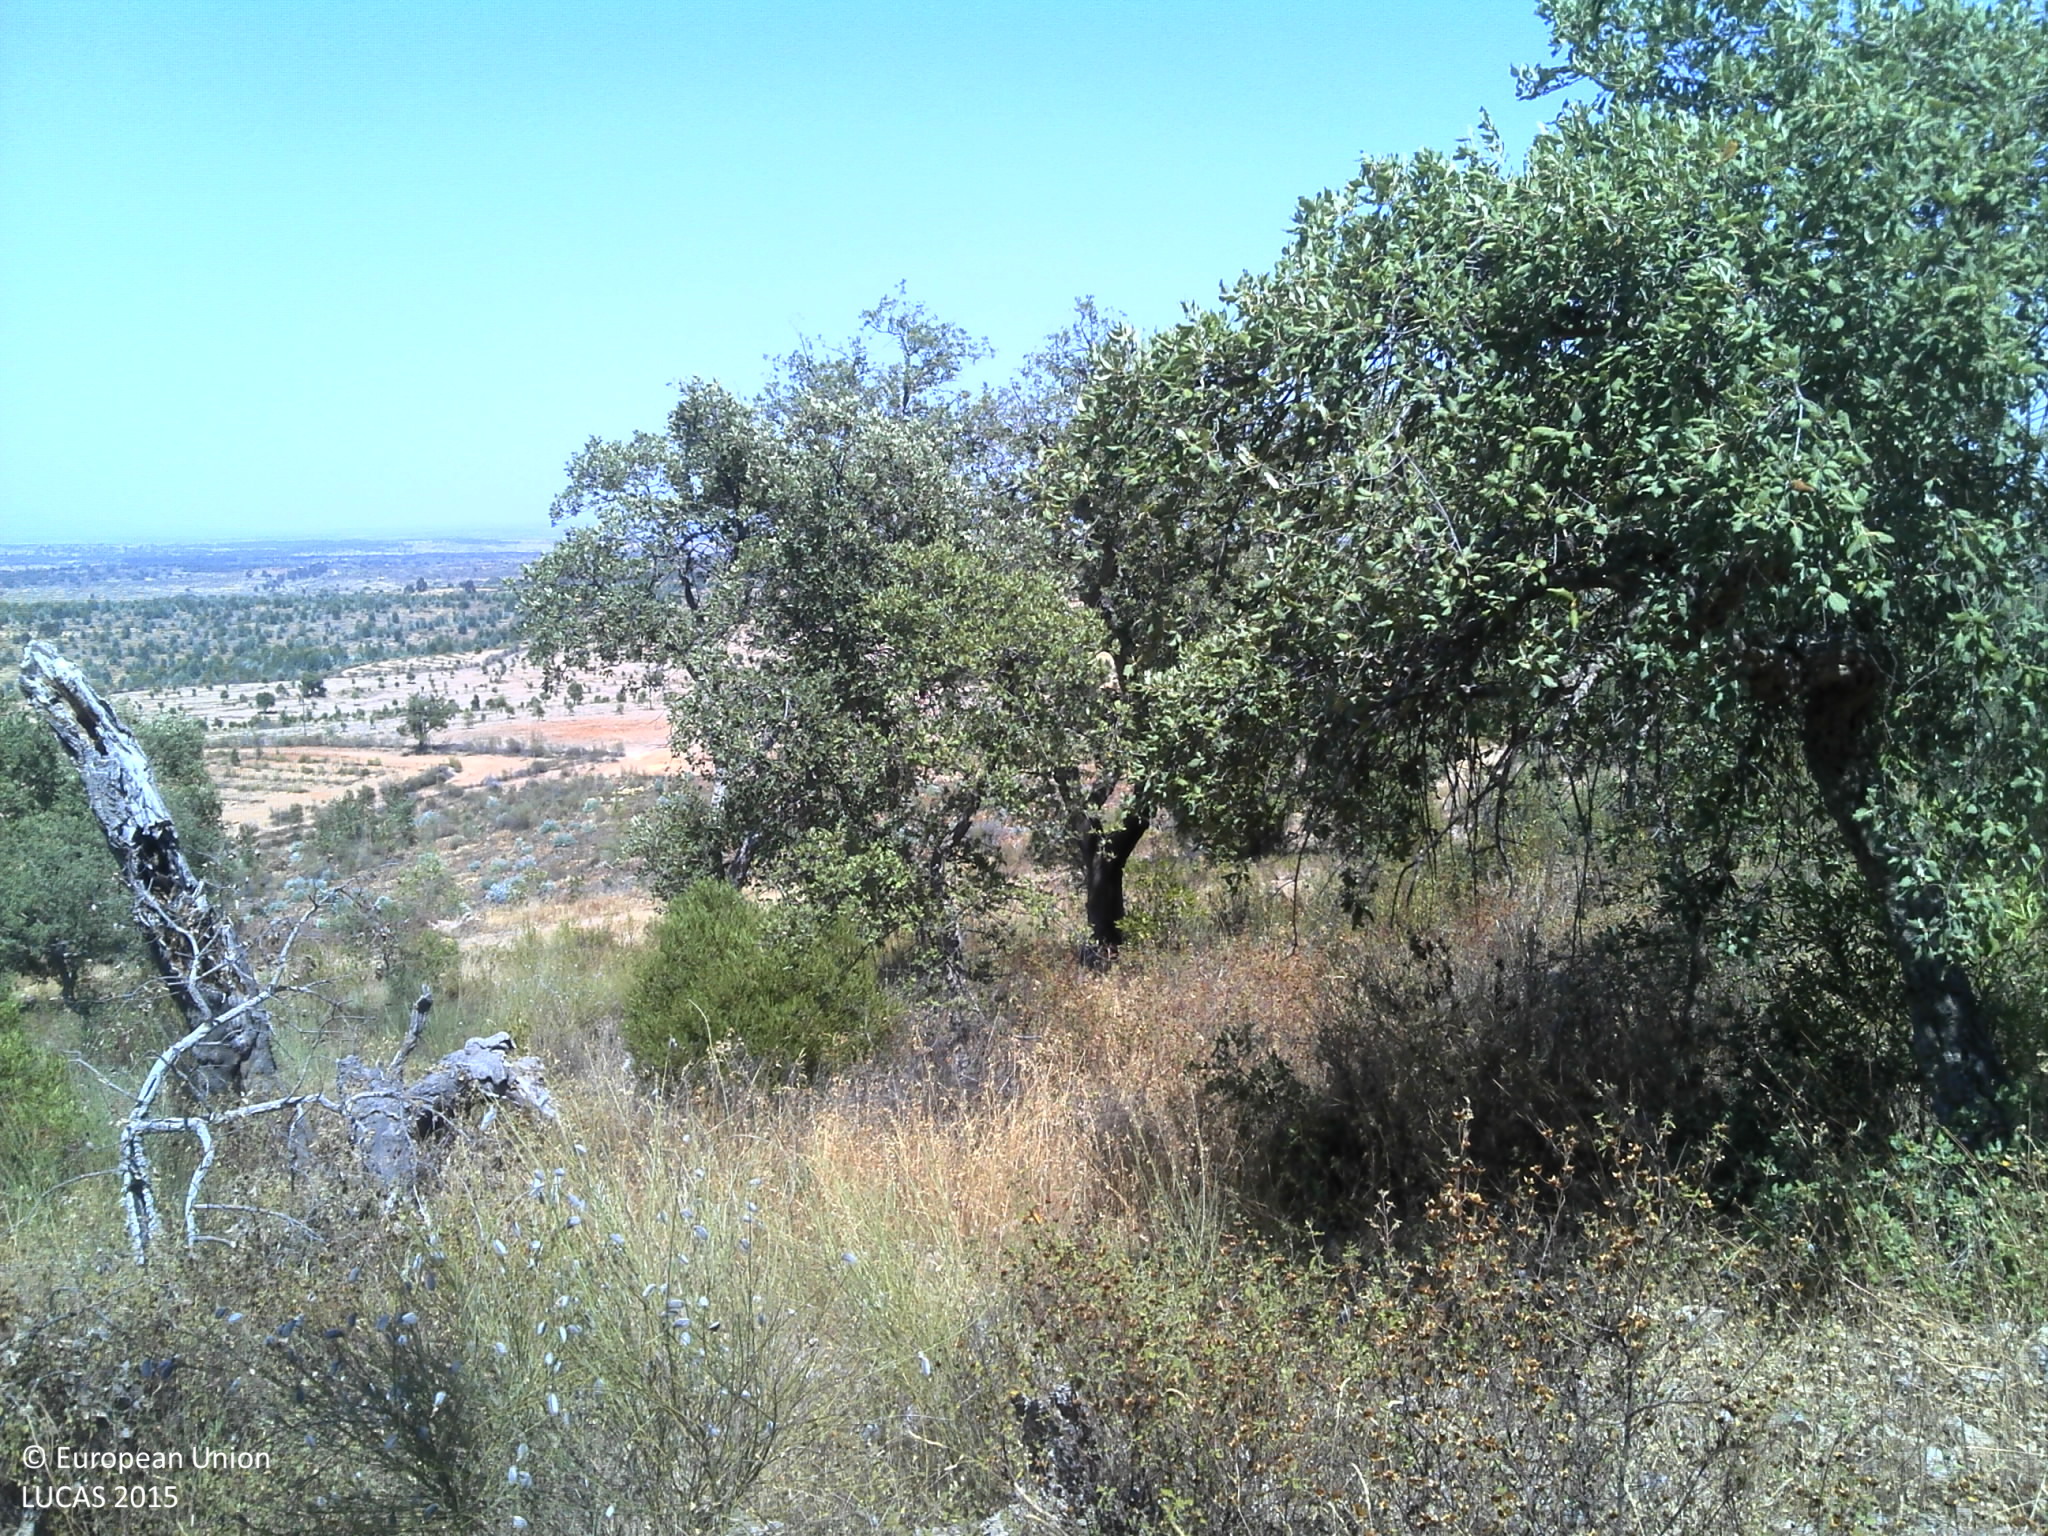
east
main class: Woodland
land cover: Broadleaved woodland
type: broadleaved evergreen forest
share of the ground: 25 - 50 %
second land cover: Grassland without tree/shrub cover
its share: 50 - 75 %
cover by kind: herbaceous plants 50 %, broadleaved forest trees 45 %, shrubs 5 %
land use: Forestry
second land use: Agriculture (excluding fallow land and kitchen gardens)
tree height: > 5 m
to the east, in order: Broadleaved woodland; Grassland without tree/shrub cover; Broadleaved woodland; Shrubland with sparse tree cover; Abandoned hedges; Olive groves; Shrubland with sparse tree cover; Electric lines; Shrubland with sparse tree cover
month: June
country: PT
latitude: 39.7492
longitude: -7.3075
